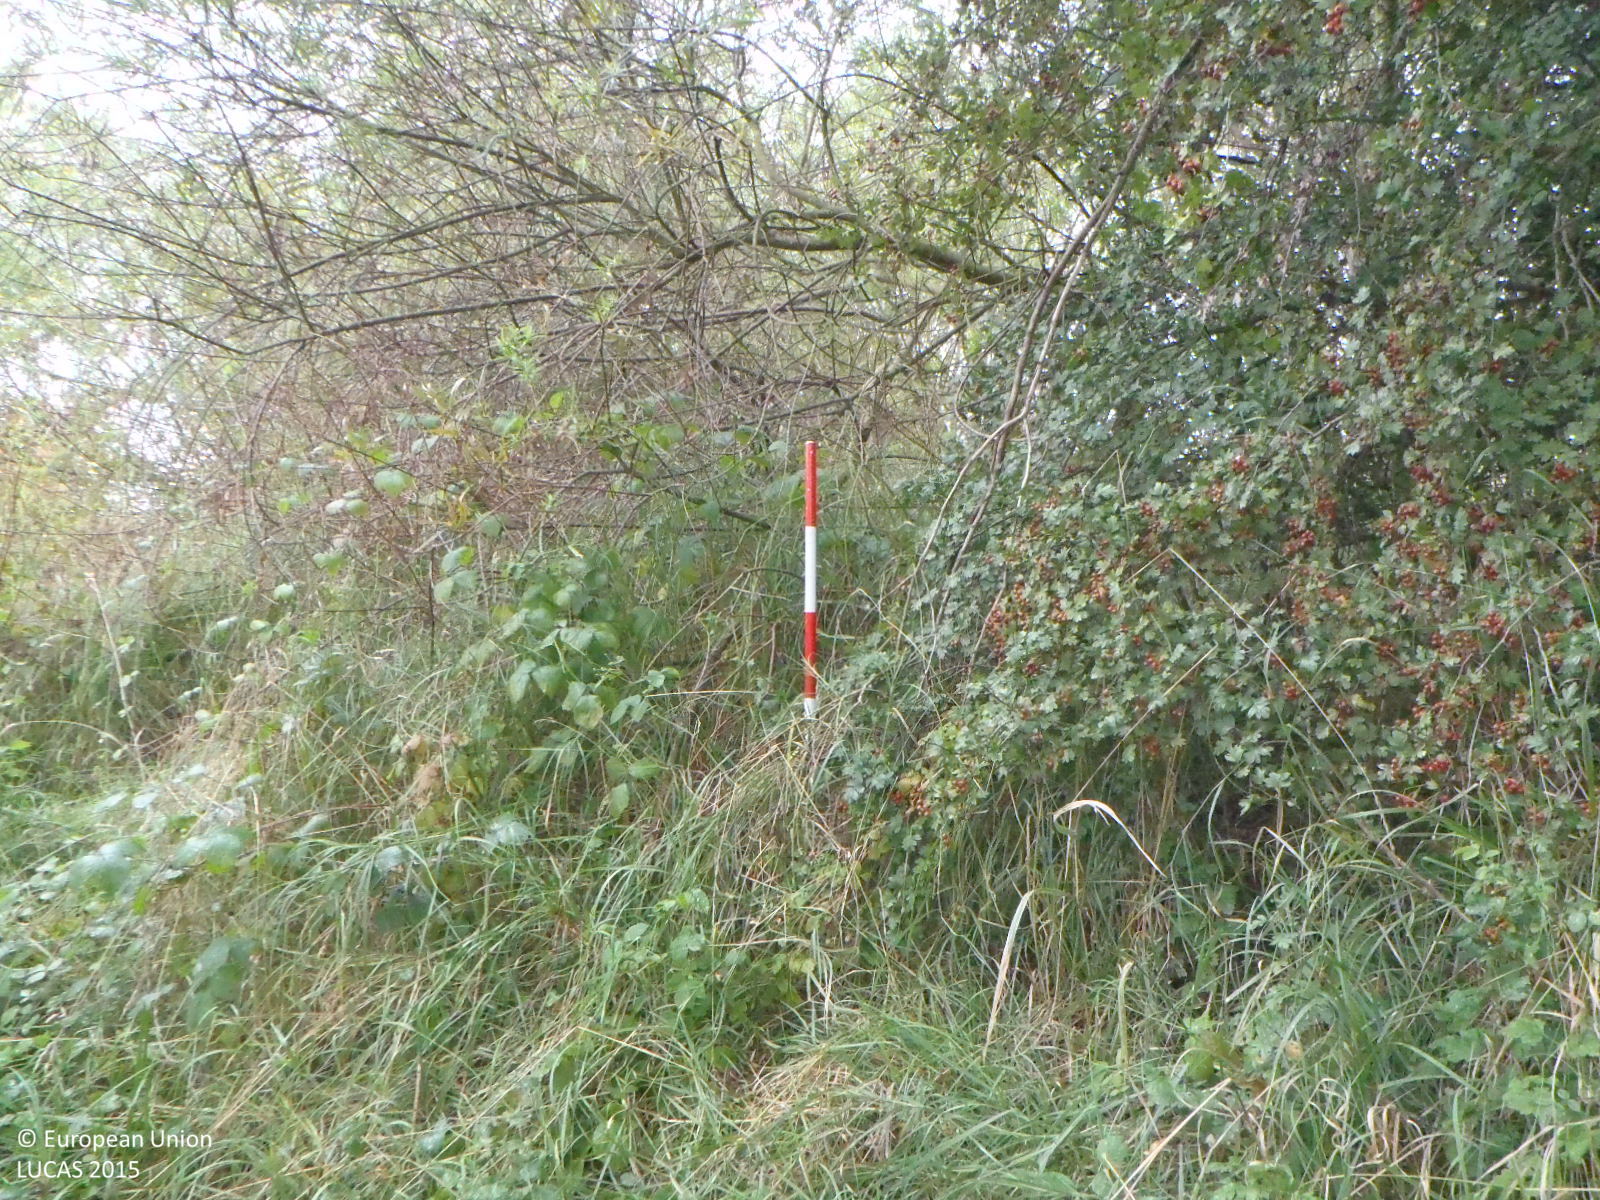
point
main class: Woodland
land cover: Broadleaved woodland
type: floodplain forest
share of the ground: > 75 %
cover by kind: broadleaved forest trees 80 %, shrubs 10 %, herbaceous plants 10 %
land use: Semi-natural and natural areas not in use
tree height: > 5 m
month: September
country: CZ
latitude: 50.6579
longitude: 13.8909
